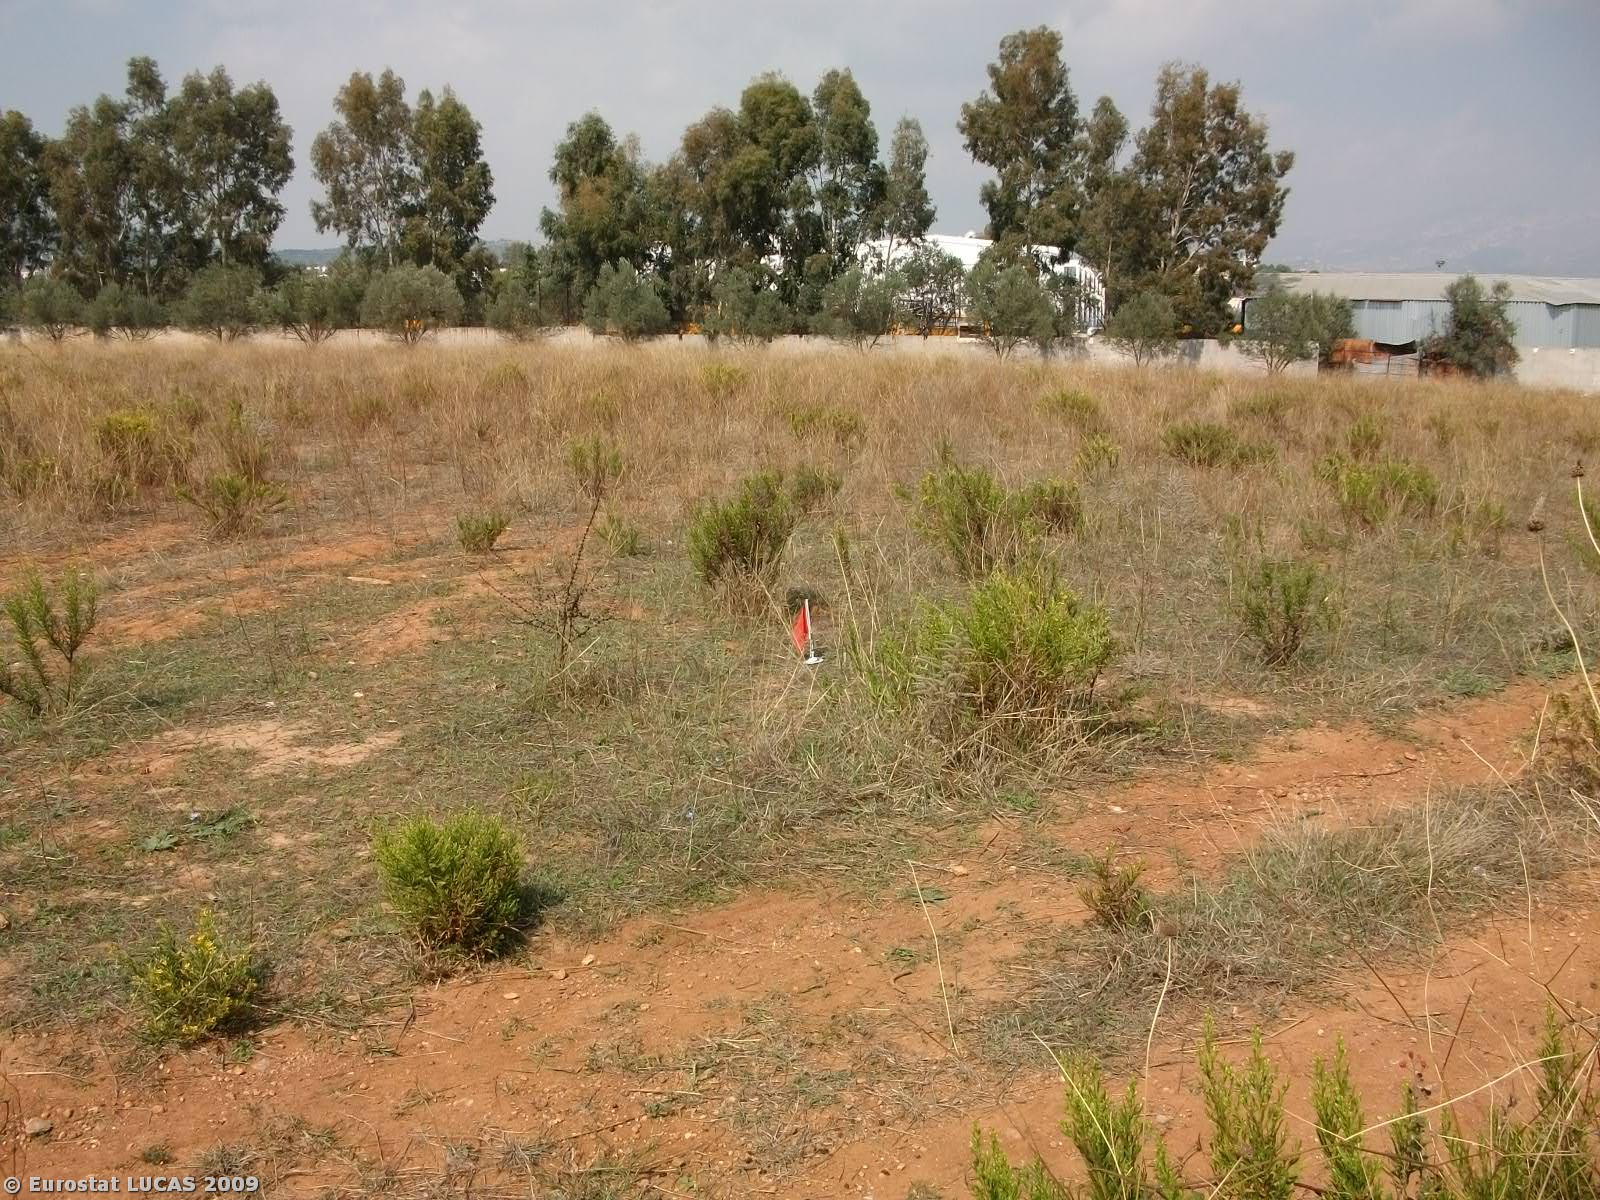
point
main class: Grassland
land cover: Grassland without tree/shrub cover
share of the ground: 50 - 75 %
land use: Agriculture (excluding fallow land and kitchen gardens)
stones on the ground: < 10 %
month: October
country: GR
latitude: 37.9761
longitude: 23.8592
